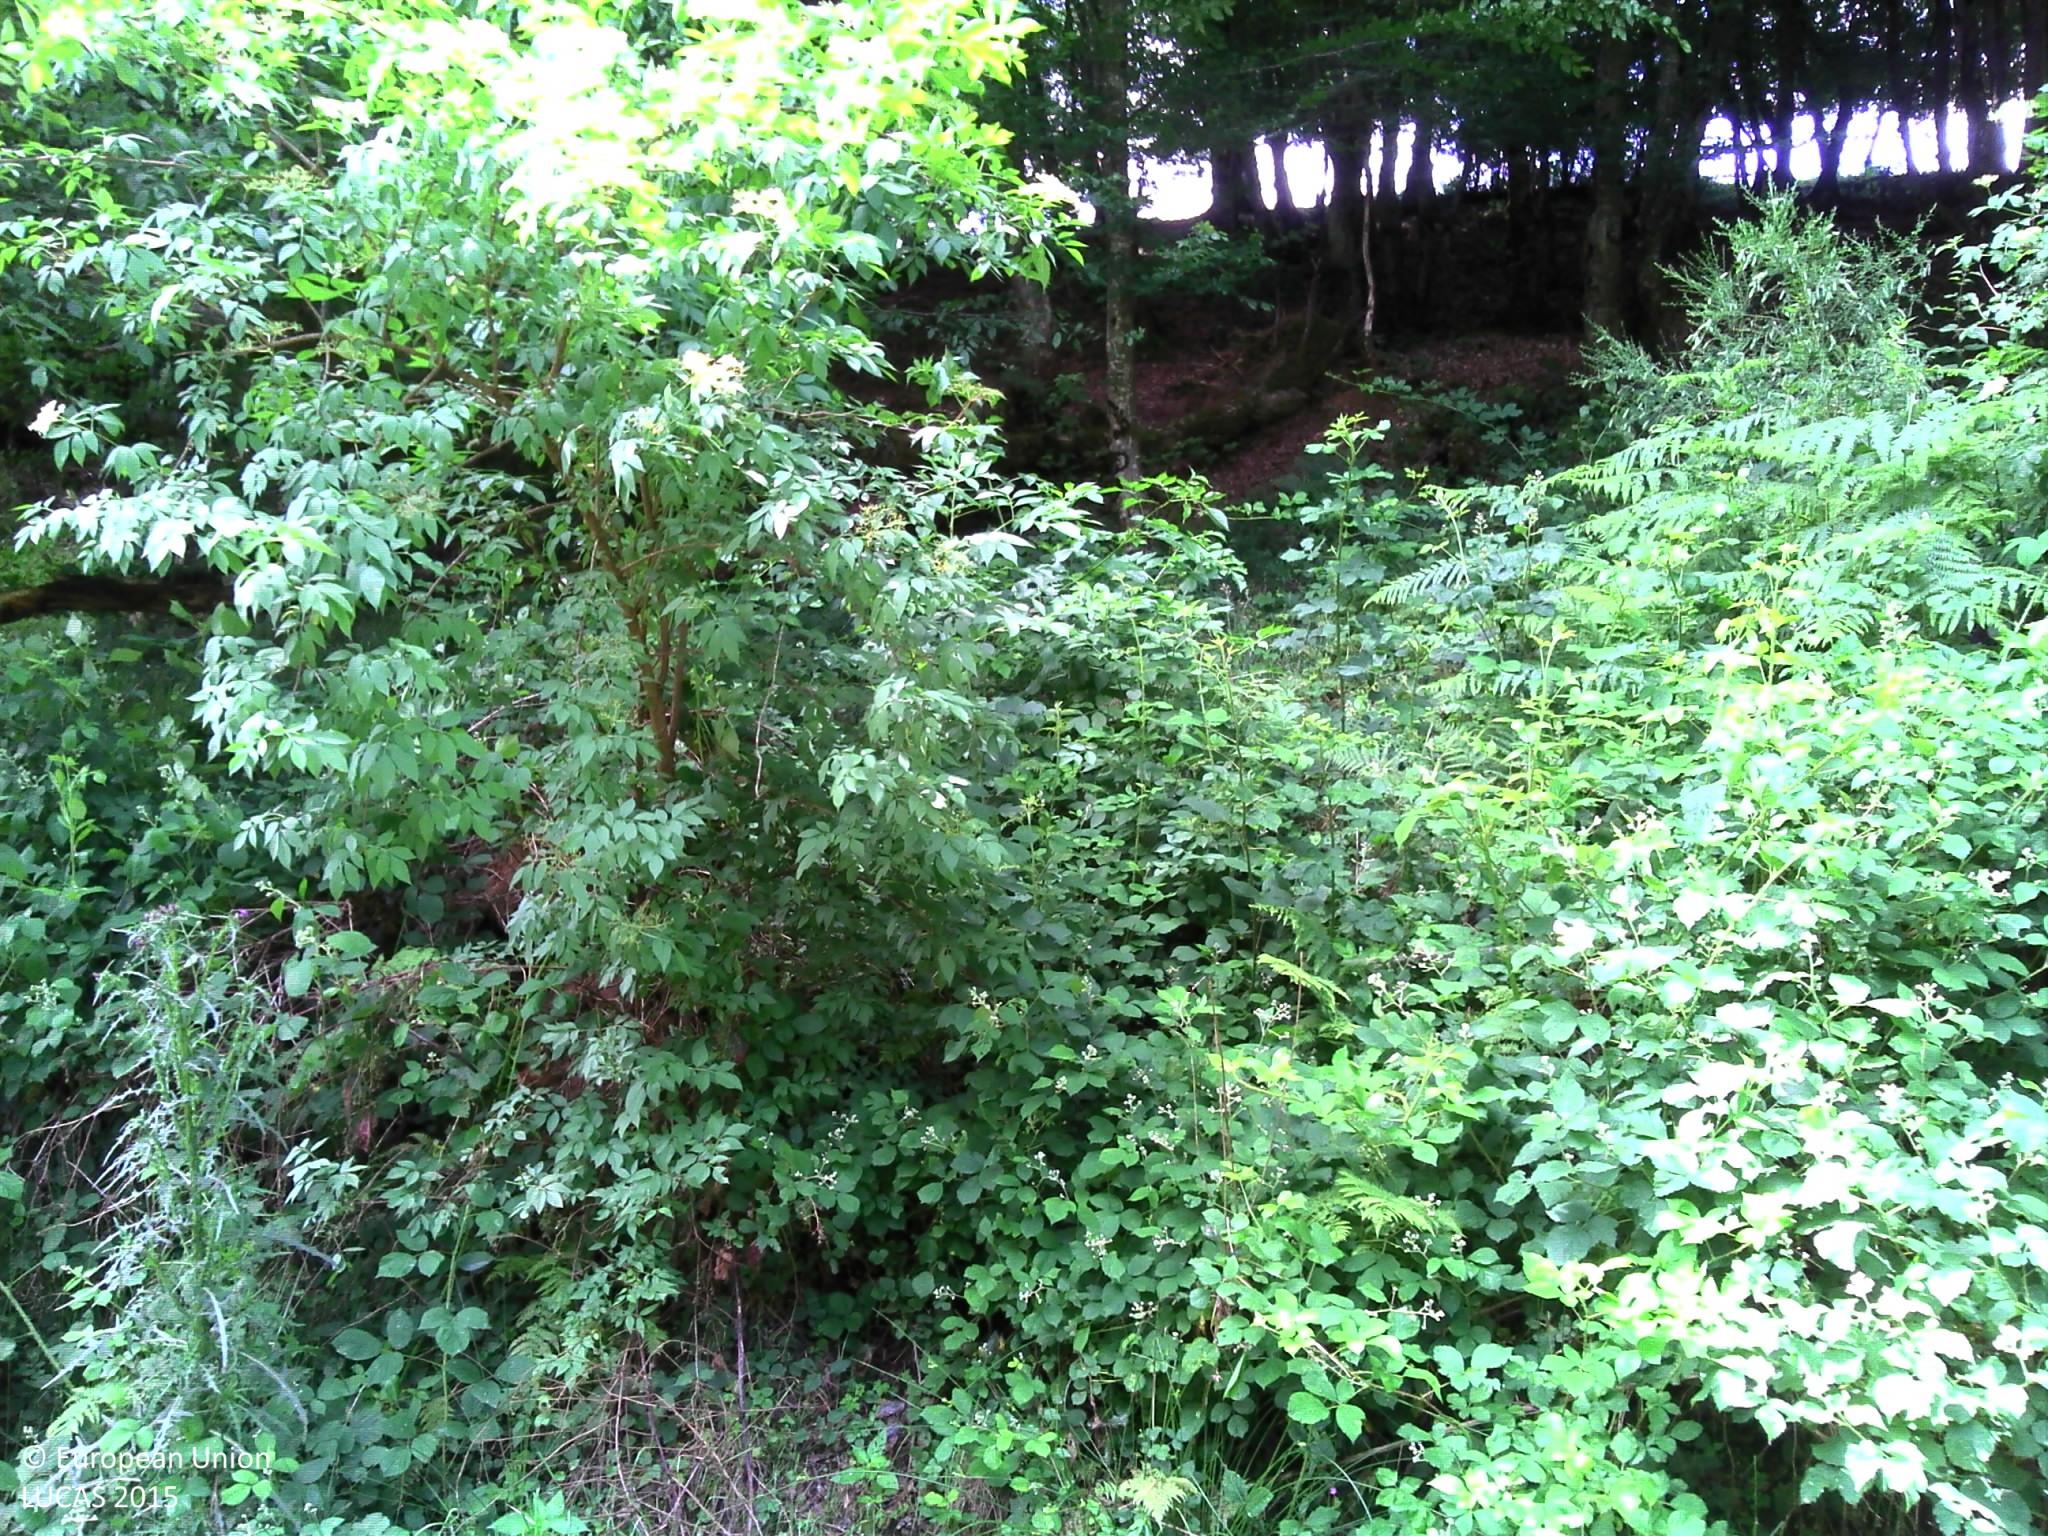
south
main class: Woodland
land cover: Broadleaved woodland
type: mesophytic deciduous forest
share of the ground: > 75 %
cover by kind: broadleaved forest trees 90 %, shrubs 10 %
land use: Forestry
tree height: > 5 m
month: June
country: FR
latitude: 46.2846
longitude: 3.0021
